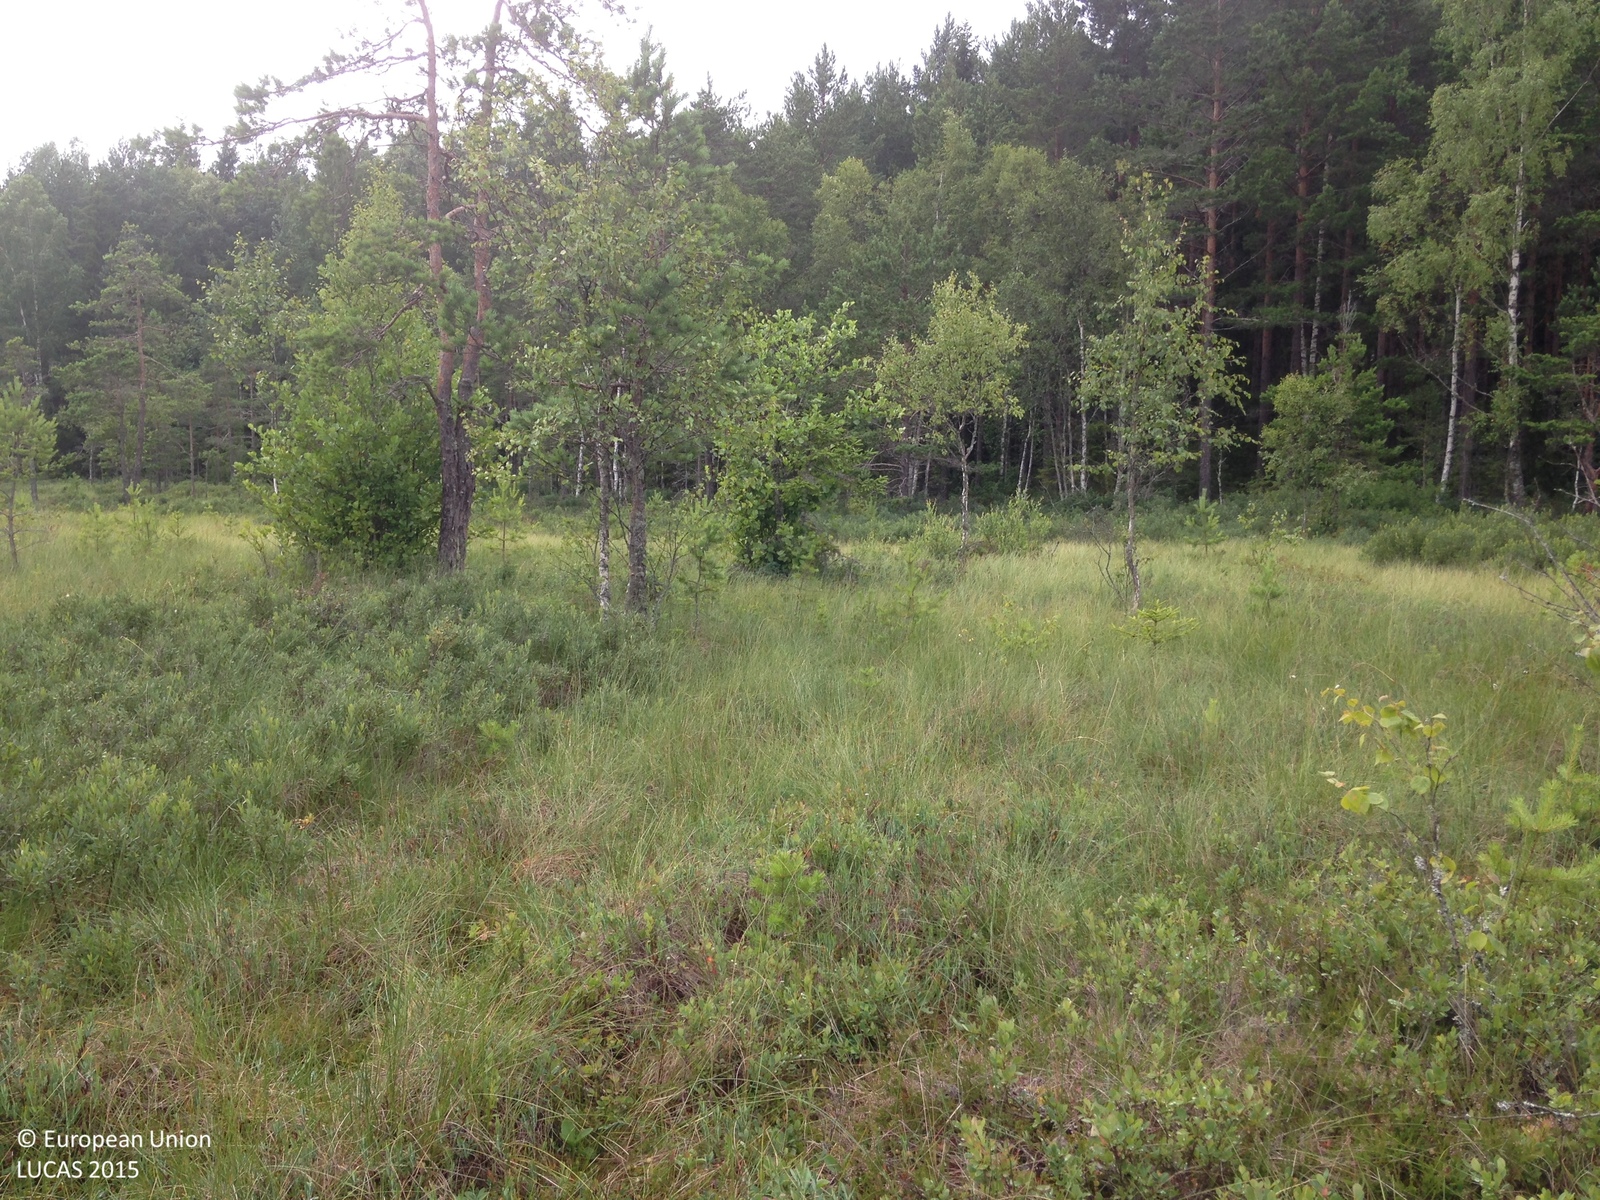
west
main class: Woodland
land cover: Pine dominated mixed woodland
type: boreal forest
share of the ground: 25 - 50 %
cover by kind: lichens and mosses 30 %, shrubs 25 %, coniferous forest trees 20 %, broadleaved forest trees 15 %, herbaceous plants 10 %
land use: Semi-natural and natural areas not in use
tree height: < 5 m
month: July
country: SE
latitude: 59.0584
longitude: 14.6478
